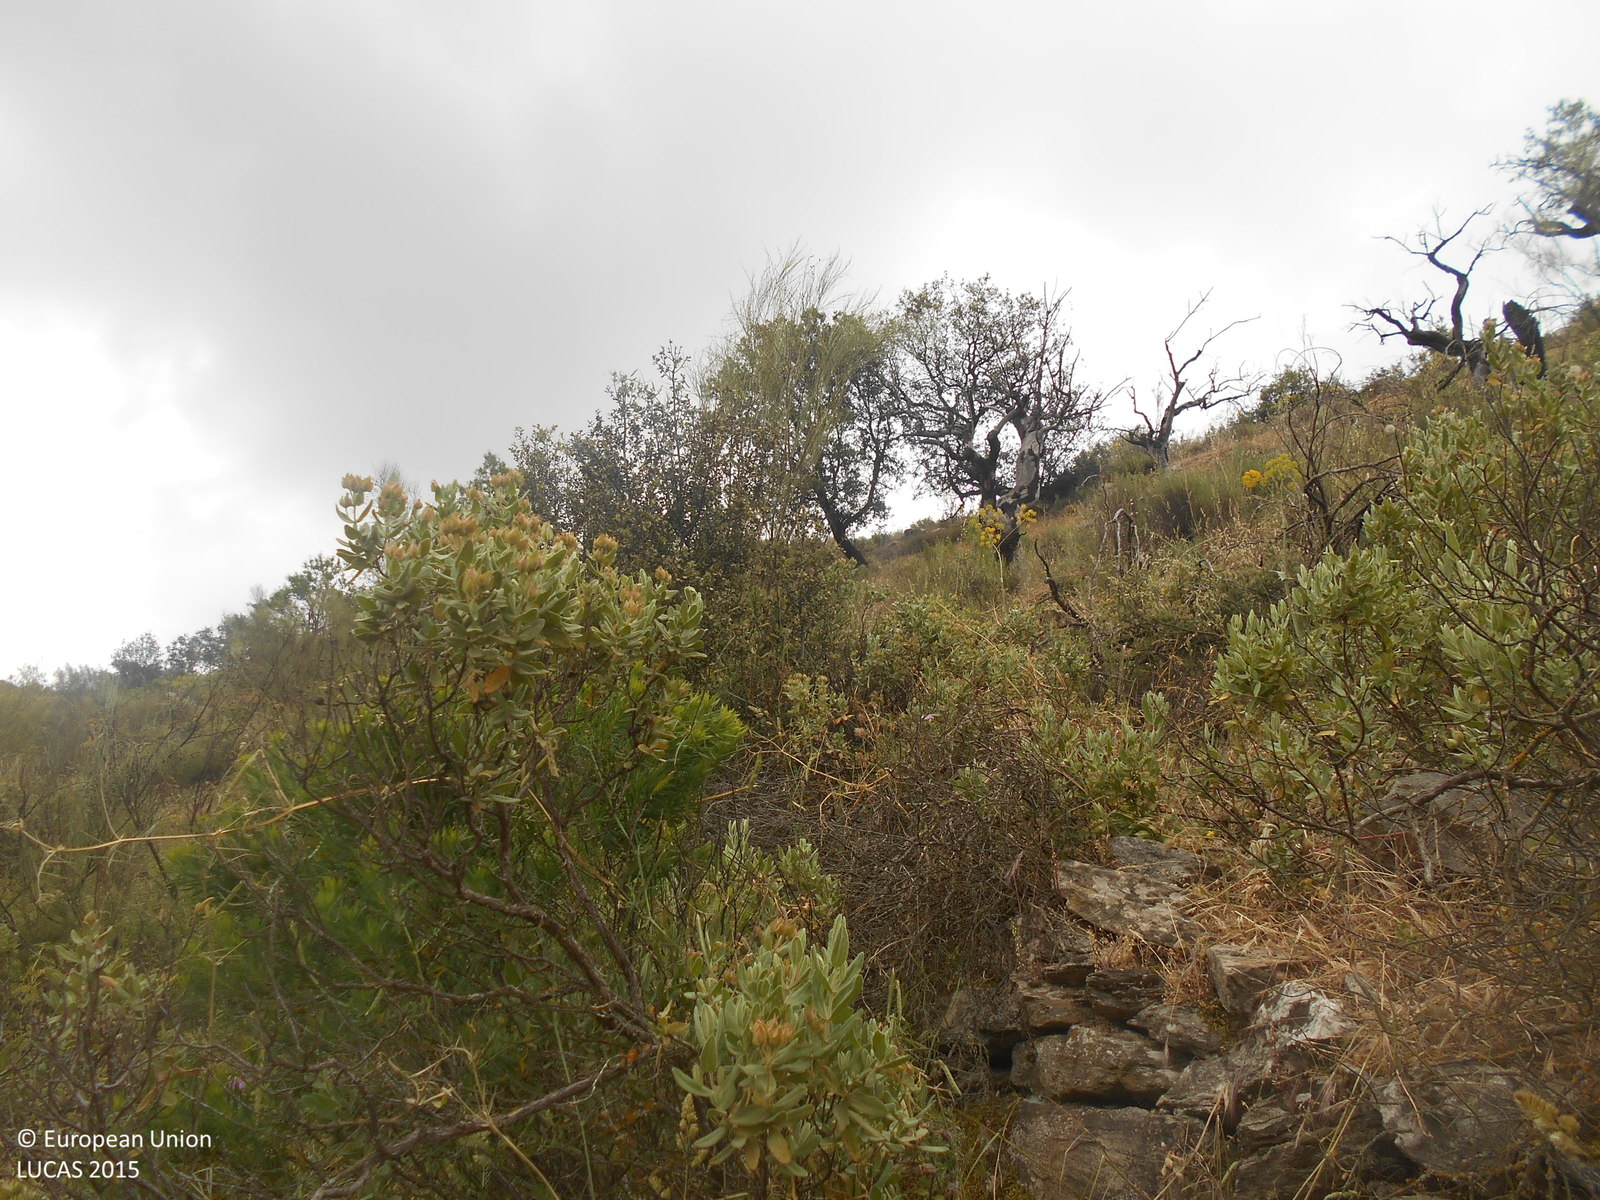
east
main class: Shrubland
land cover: Shrubland with sparse tree cover
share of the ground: > 75 %
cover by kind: shrubs 80 %, herbaceous plants 15 %, broadleaved forest trees 5 %
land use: Semi-natural and natural areas not in use
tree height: < 5 m
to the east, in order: Shrubland with sparse tree cover; Tracks; Shrubland with sparse tree cover; Broadleaved woodland; Tracks; Broadleaved woodland; Shrubland with sparse tree cover
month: May
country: ES
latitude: 37.2175
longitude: -2.1836
